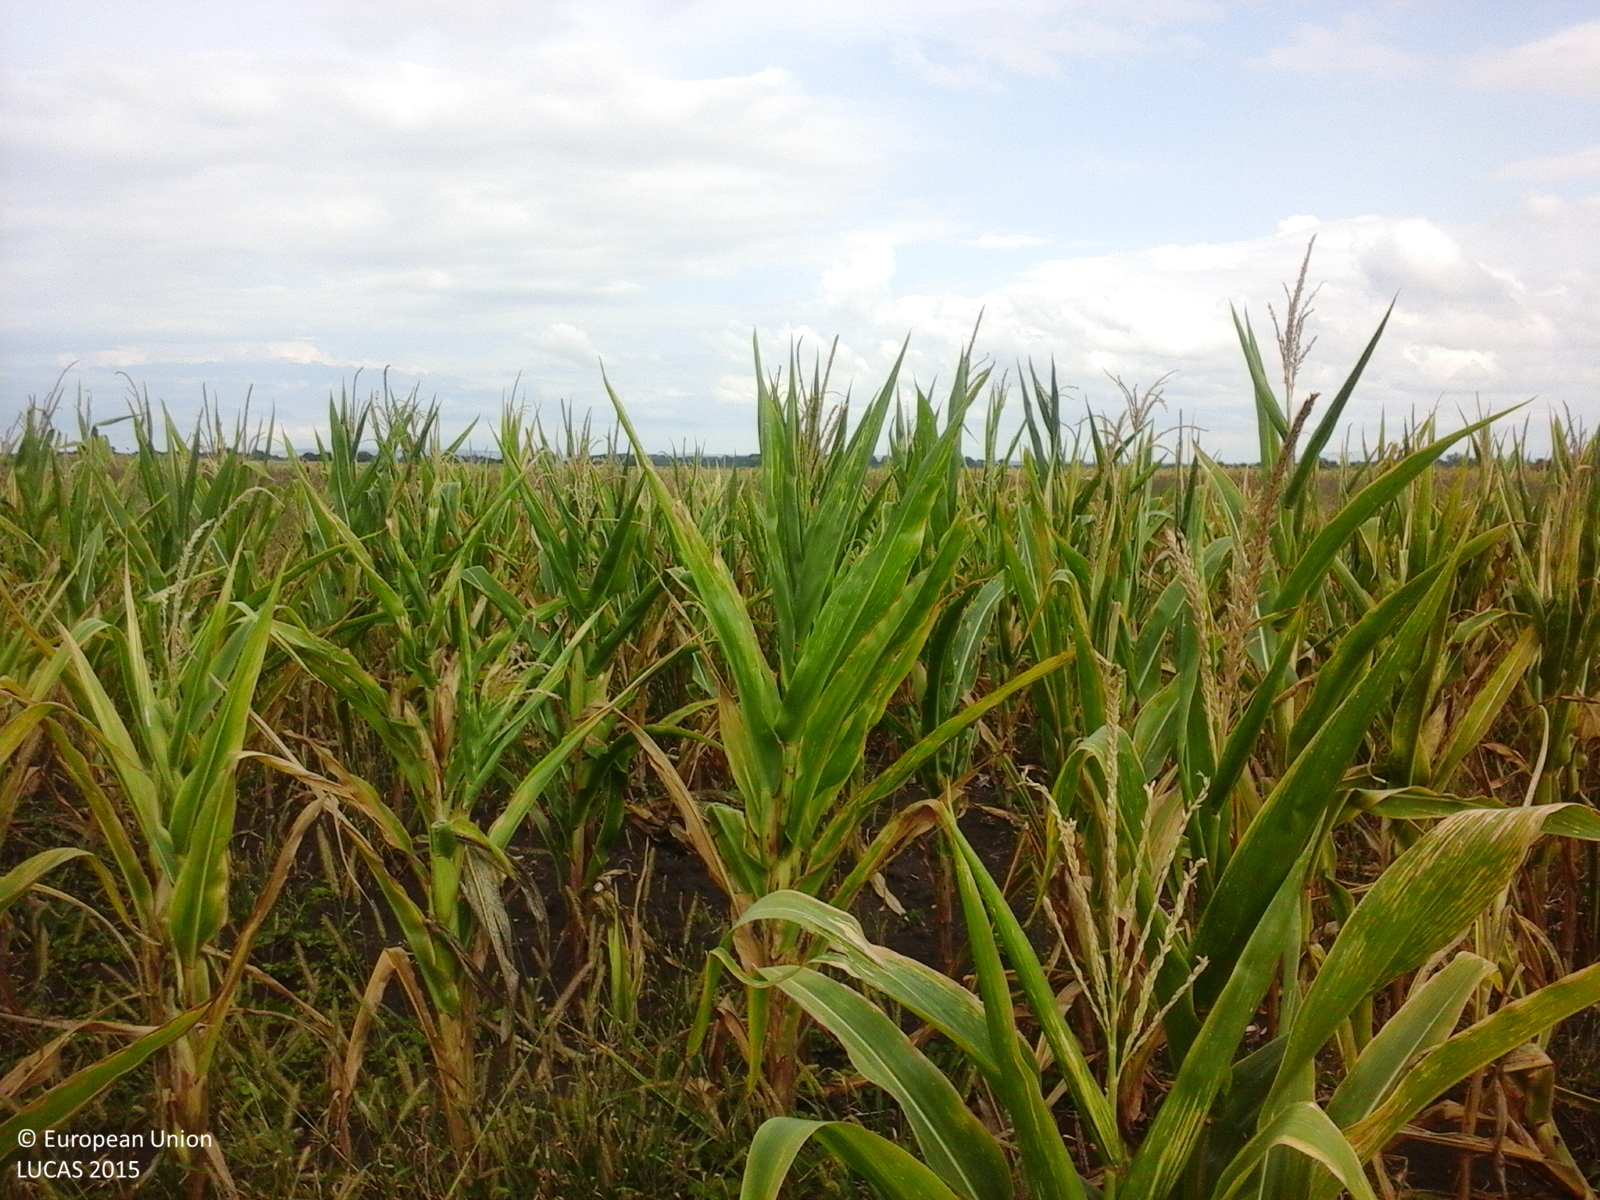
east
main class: Cropland
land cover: Maize
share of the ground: > 75 %
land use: Agriculture (excluding fallow land and kitchen gardens)
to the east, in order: Maize; Spontaneously vegetated surfaces; Maize; Spontaneously vegetated surfaces; Other bare soil; Spontaneously vegetated surfaces
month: August
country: RO
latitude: 45.5911
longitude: 21.4275
